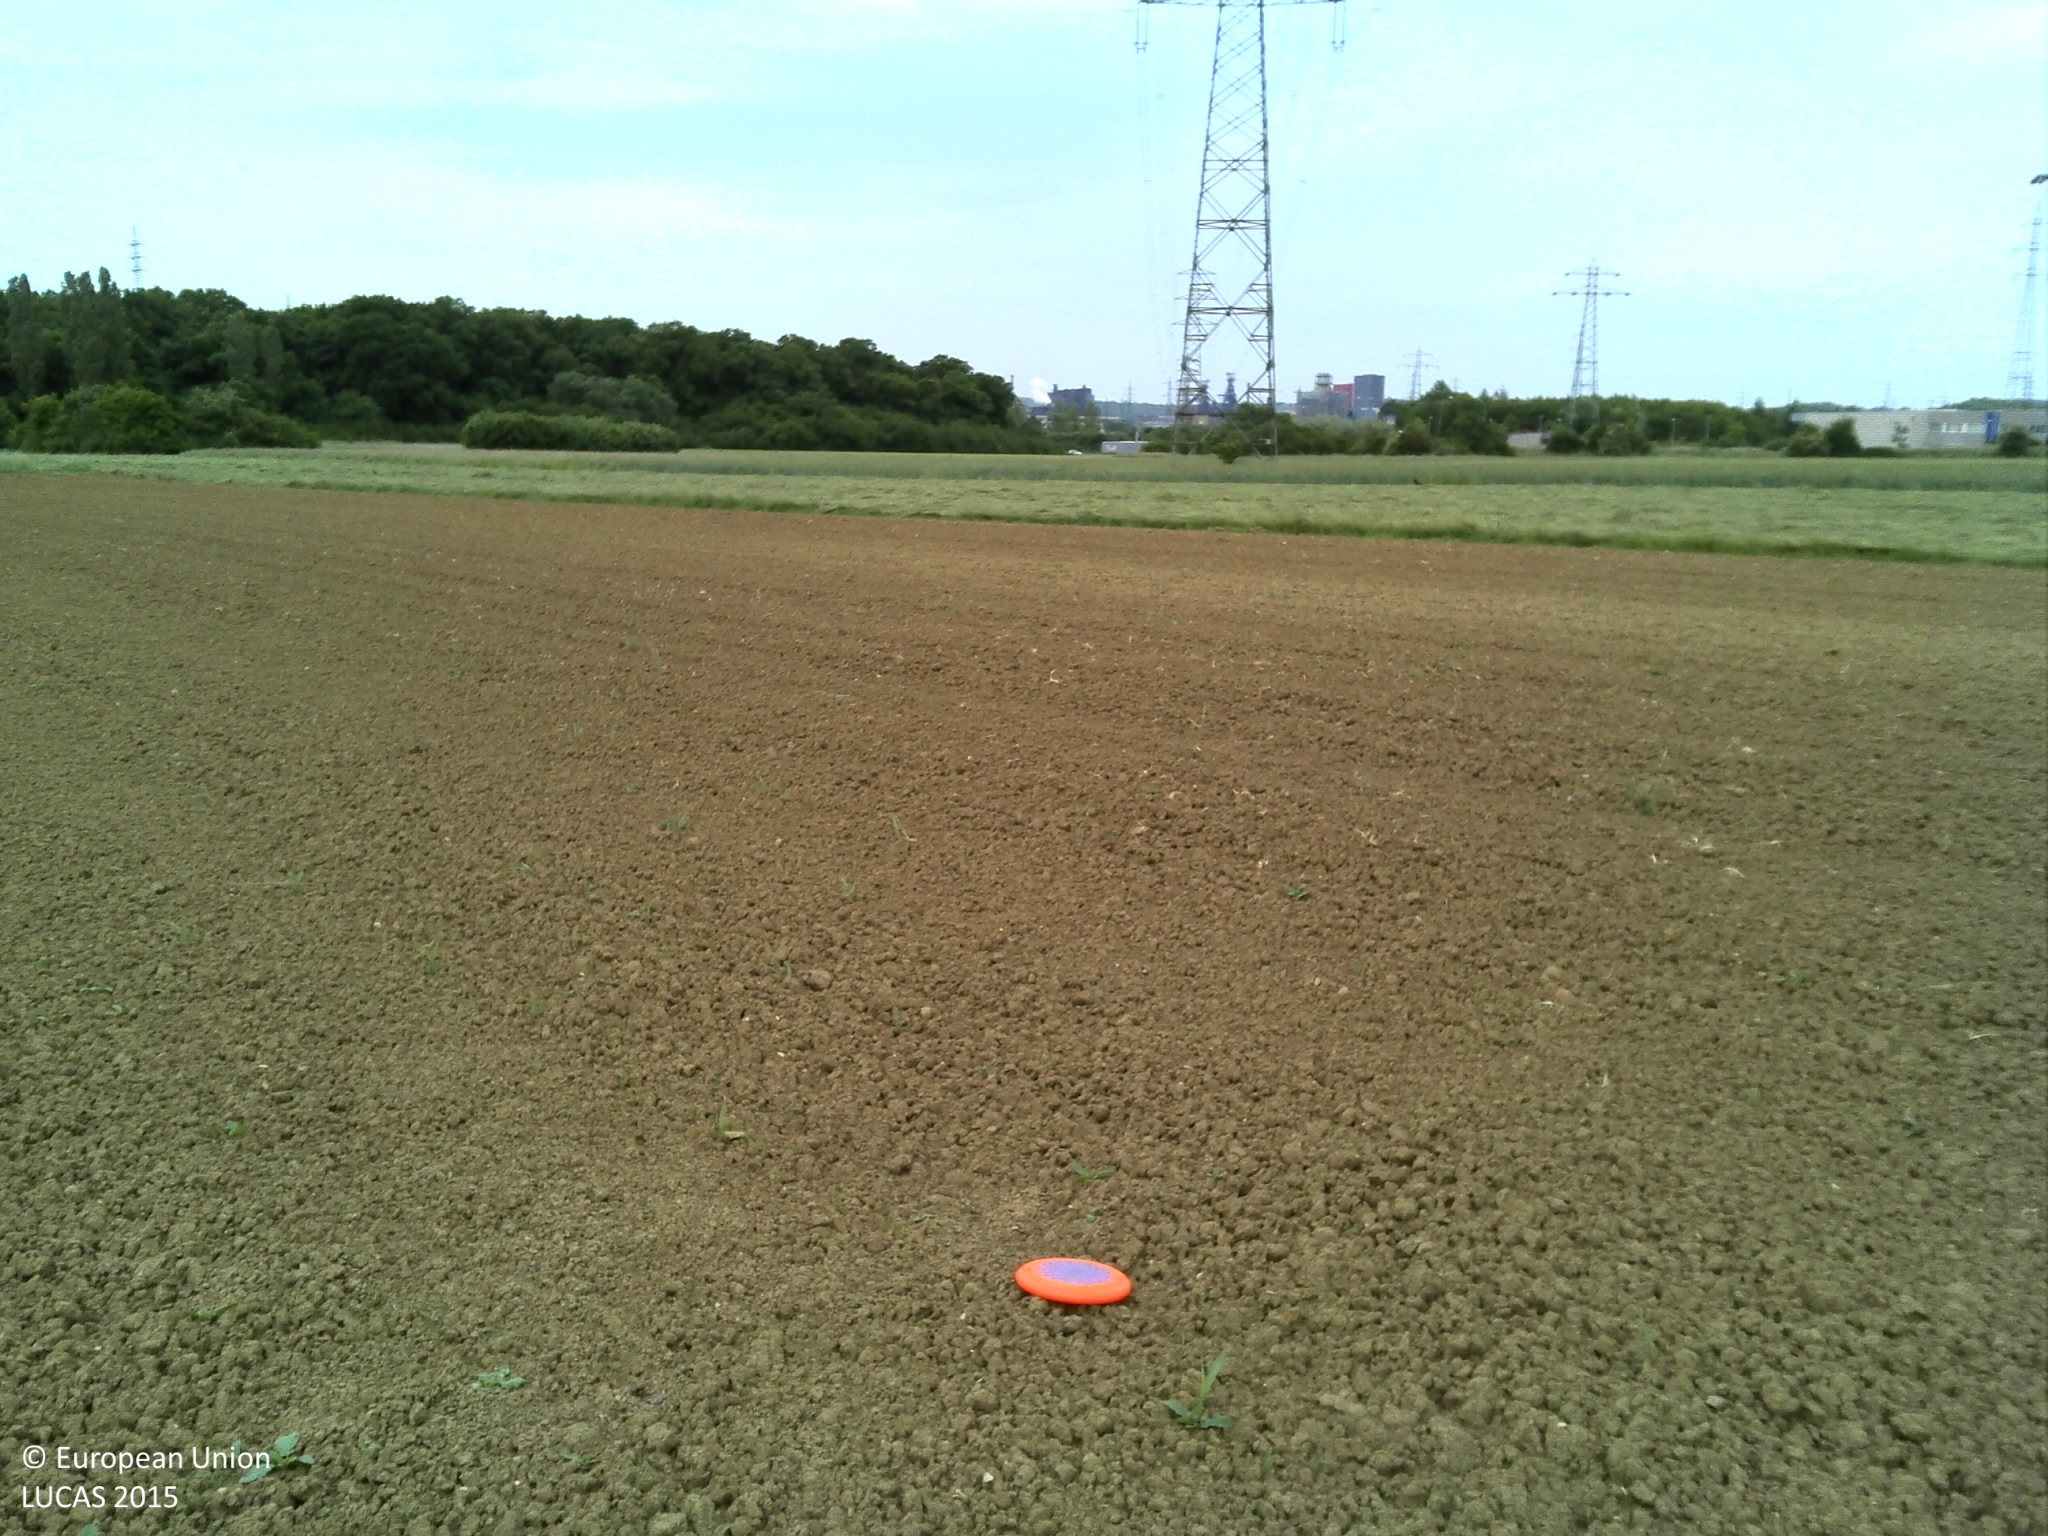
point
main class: Cropland
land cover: Maize
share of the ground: < 10 %
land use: Agriculture (excluding fallow land and kitchen gardens)
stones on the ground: < 10 %
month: June
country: LU
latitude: 49.5192
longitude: 5.9796
